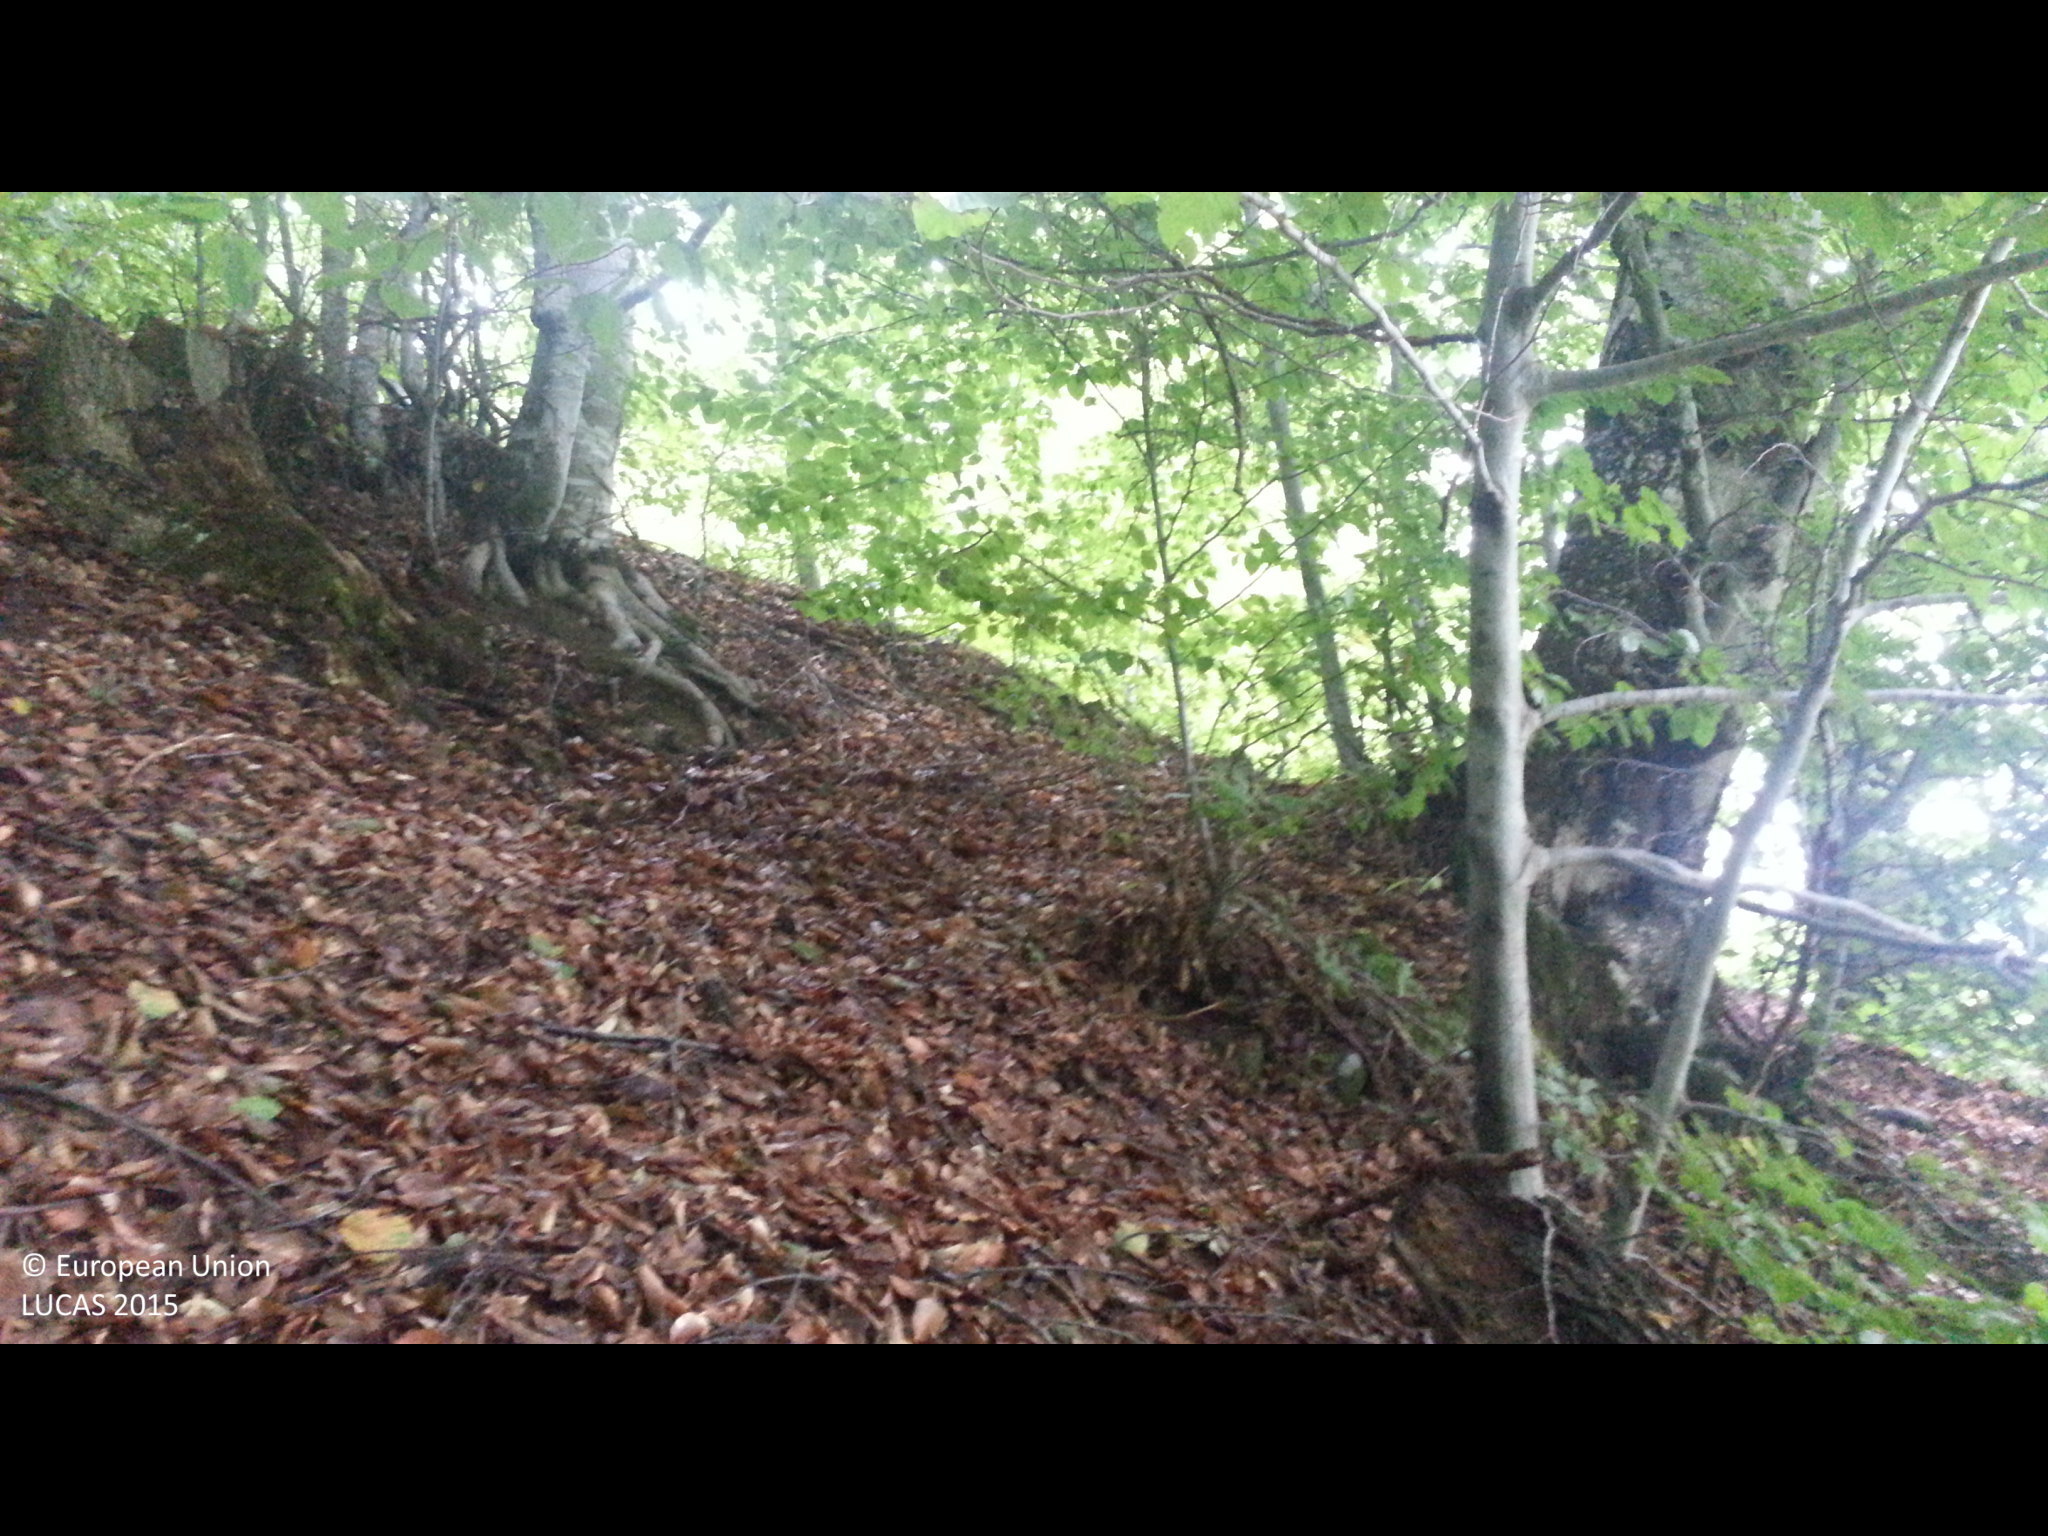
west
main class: Woodland
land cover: Broadleaved woodland
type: mountainous beech forest
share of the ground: > 75 %
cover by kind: broadleaved forest trees 95 %, shrubs 5 %
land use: Forestry
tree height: > 5 m
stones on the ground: < 10 %
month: September
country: BG
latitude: 42.3998
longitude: 22.5468
